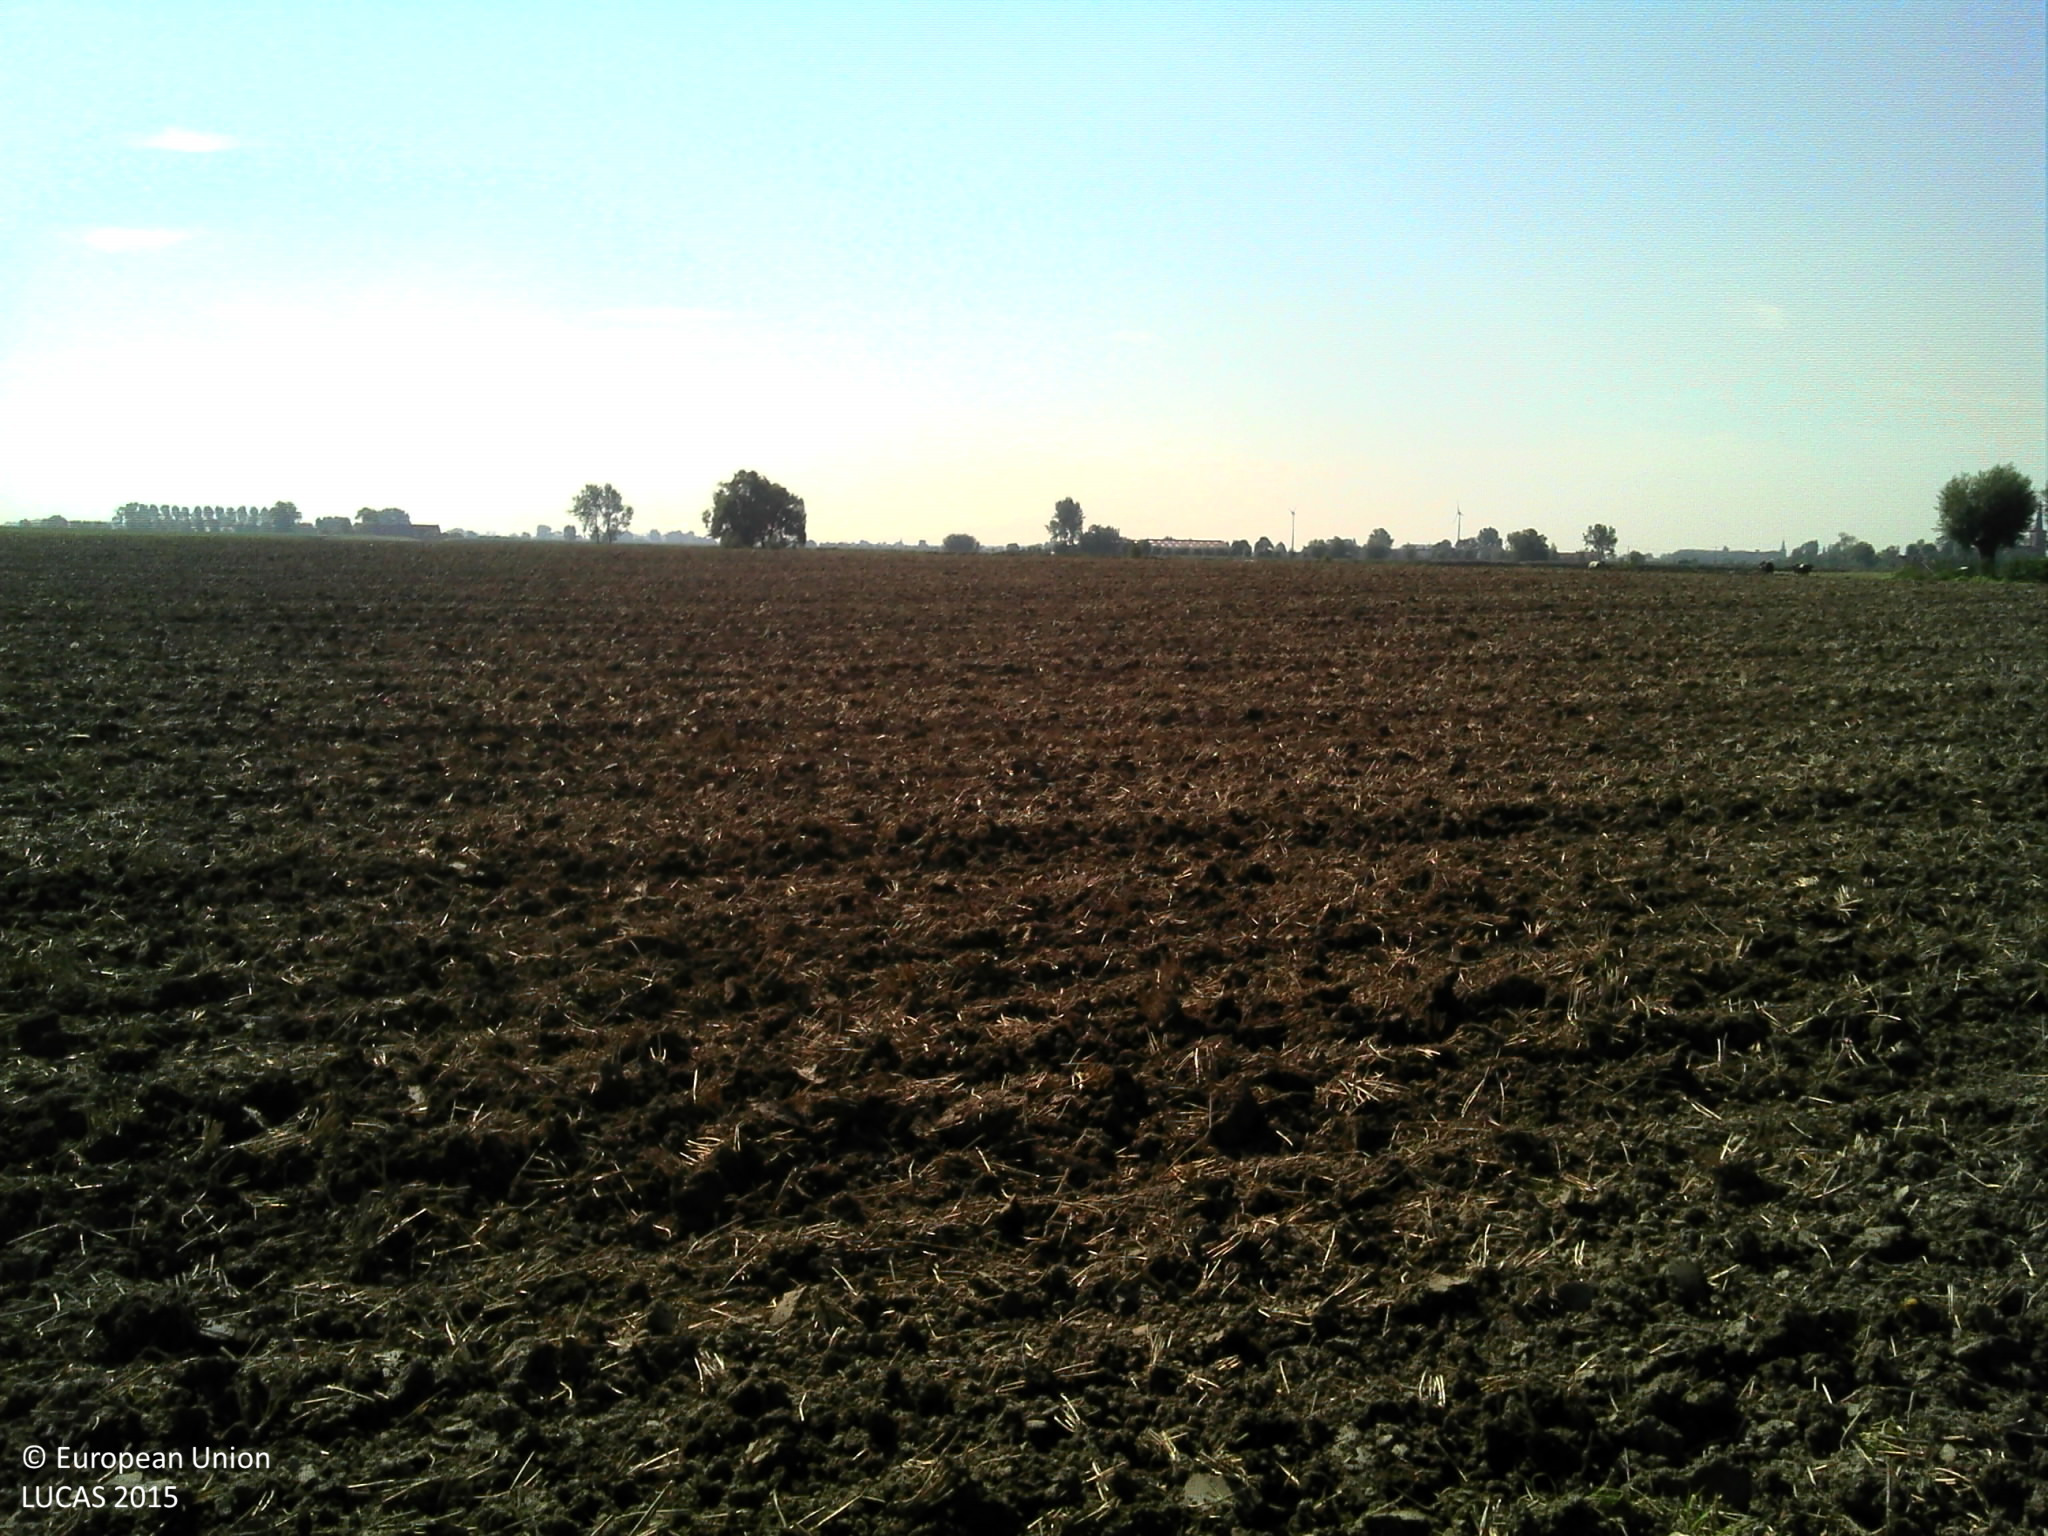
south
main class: Cropland
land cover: Common wheat
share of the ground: 50 - 75 %
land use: Agriculture (excluding fallow land and kitchen gardens)
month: September
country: BE
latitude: 51.0227
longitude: 2.8178
